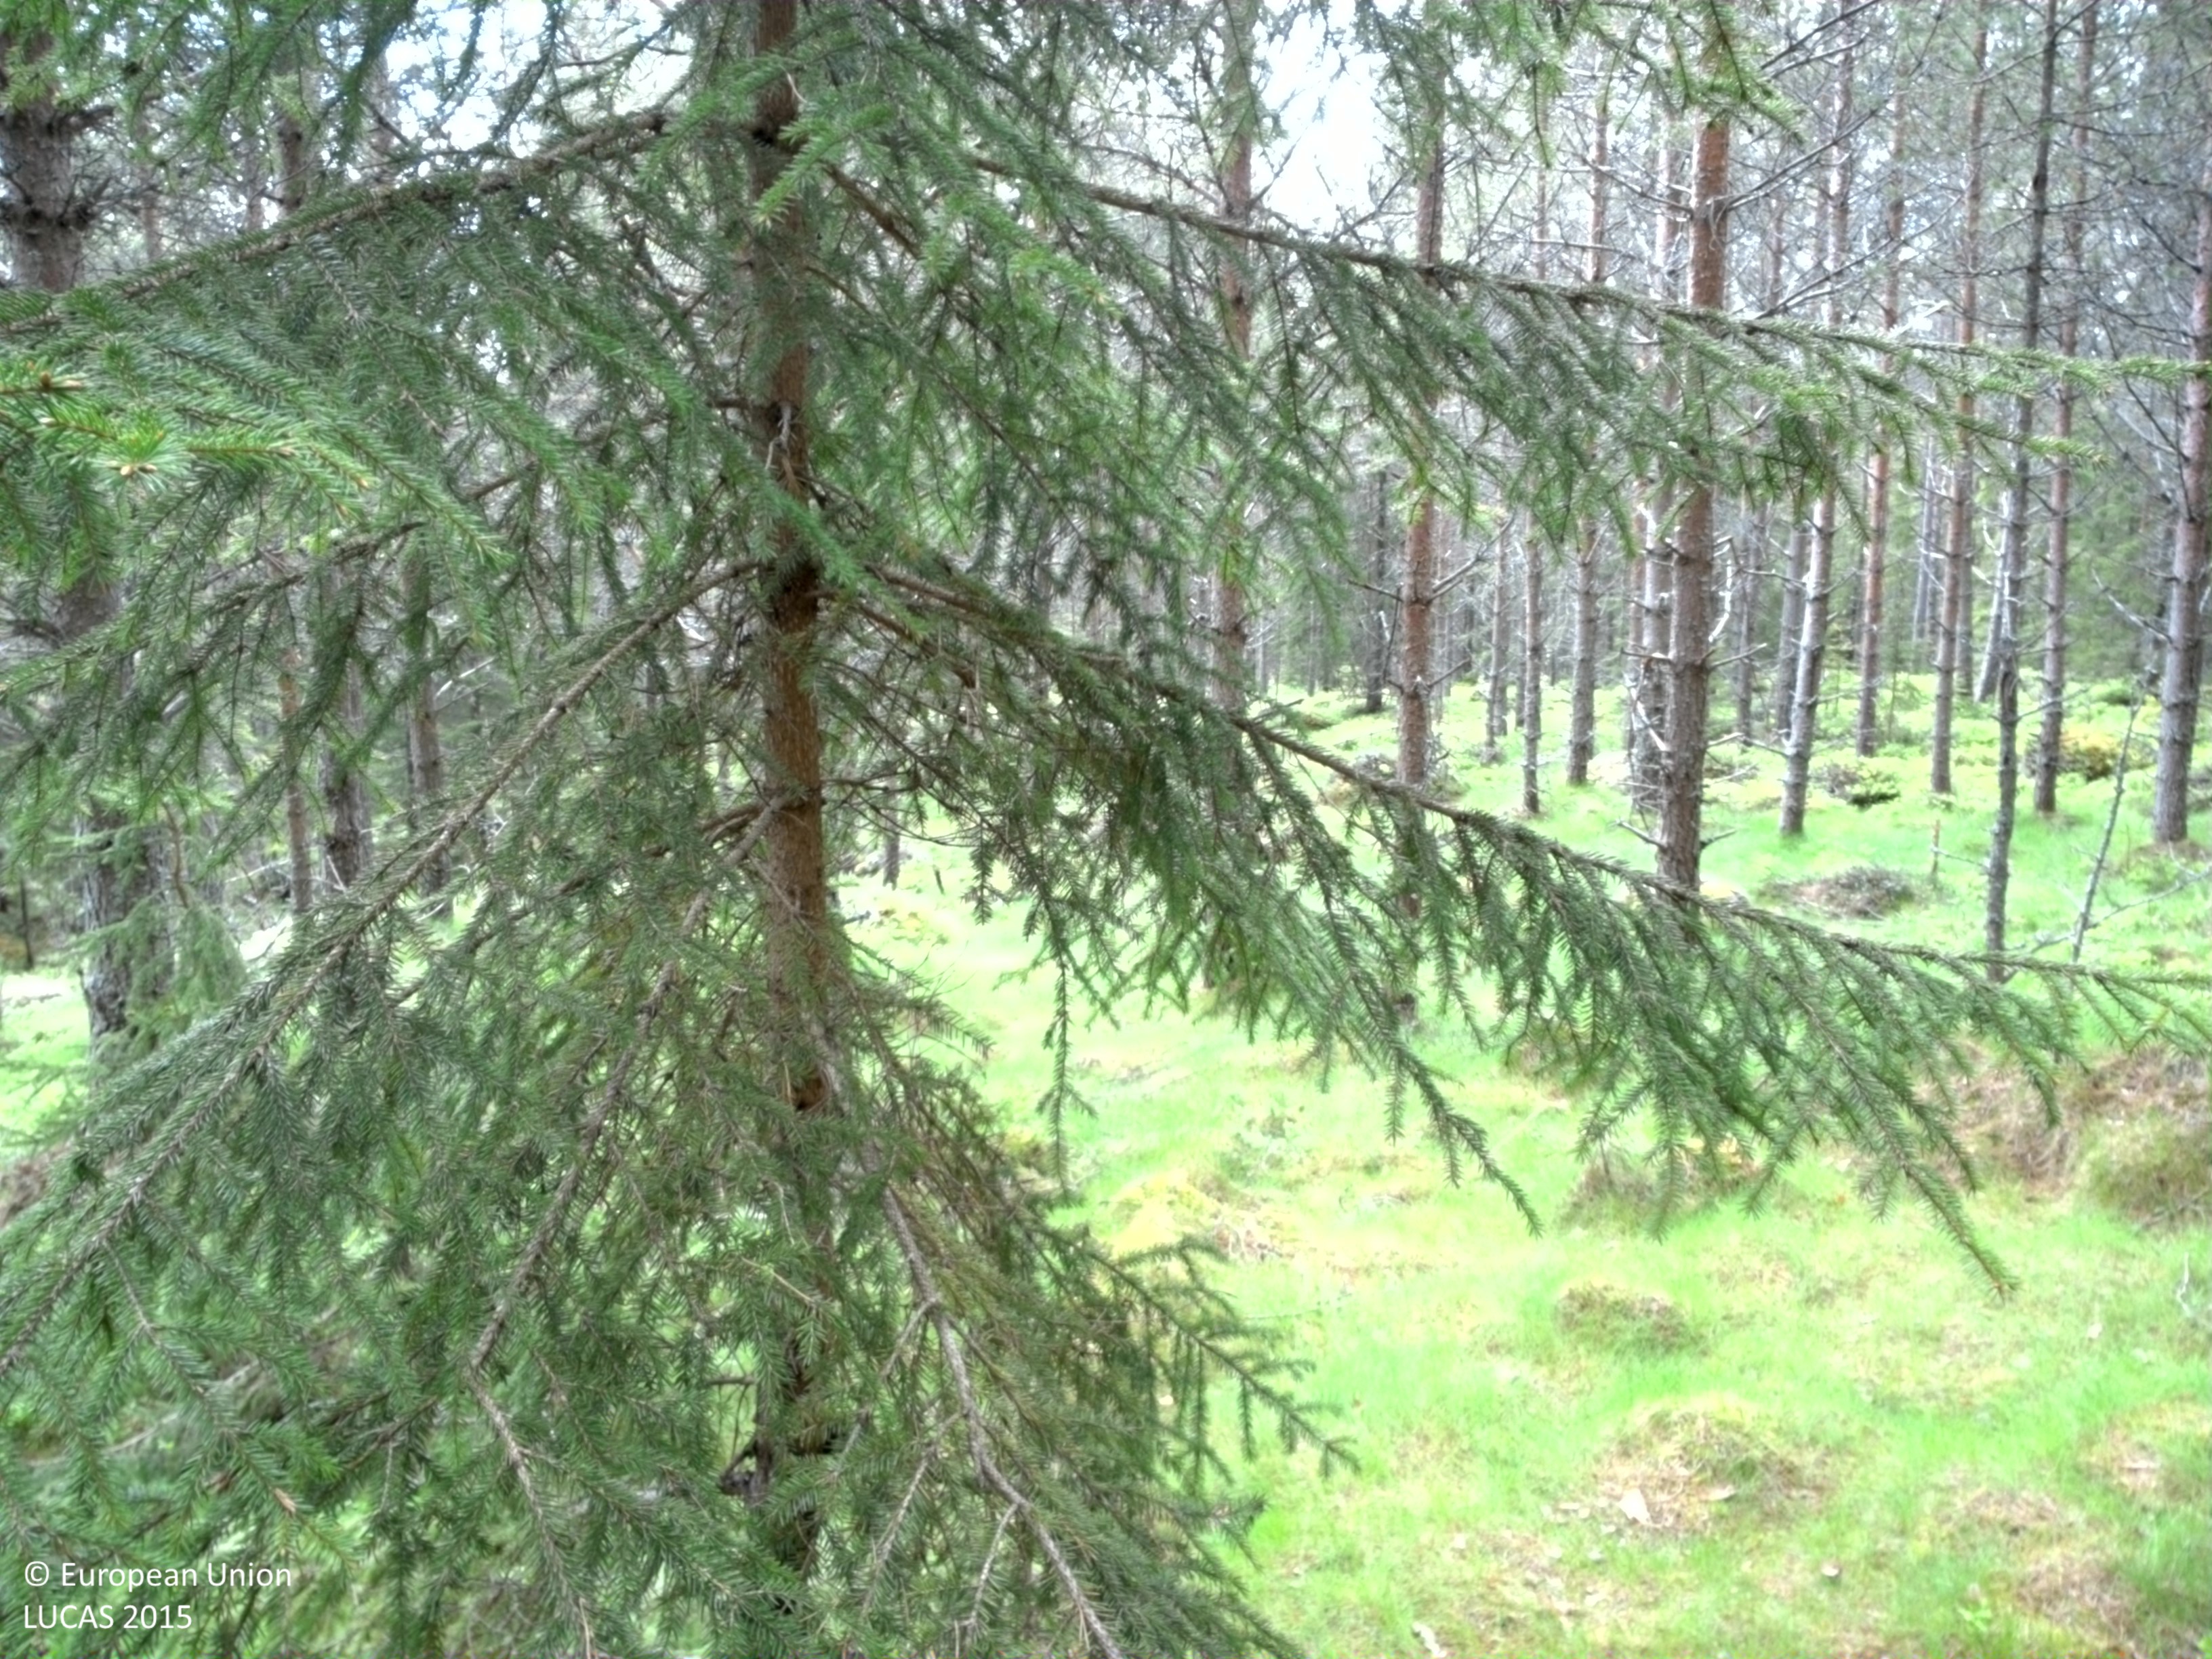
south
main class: Woodland
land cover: Pine dominated coniferous woodland
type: boreal forest
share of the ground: 50 - 75 %
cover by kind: coniferous forest trees 60 %, herbaceous plants 30 %, shrubs 10 %
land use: Forestry
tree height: > 5 m
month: June
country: SE
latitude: 60.3246
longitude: 13.1958
